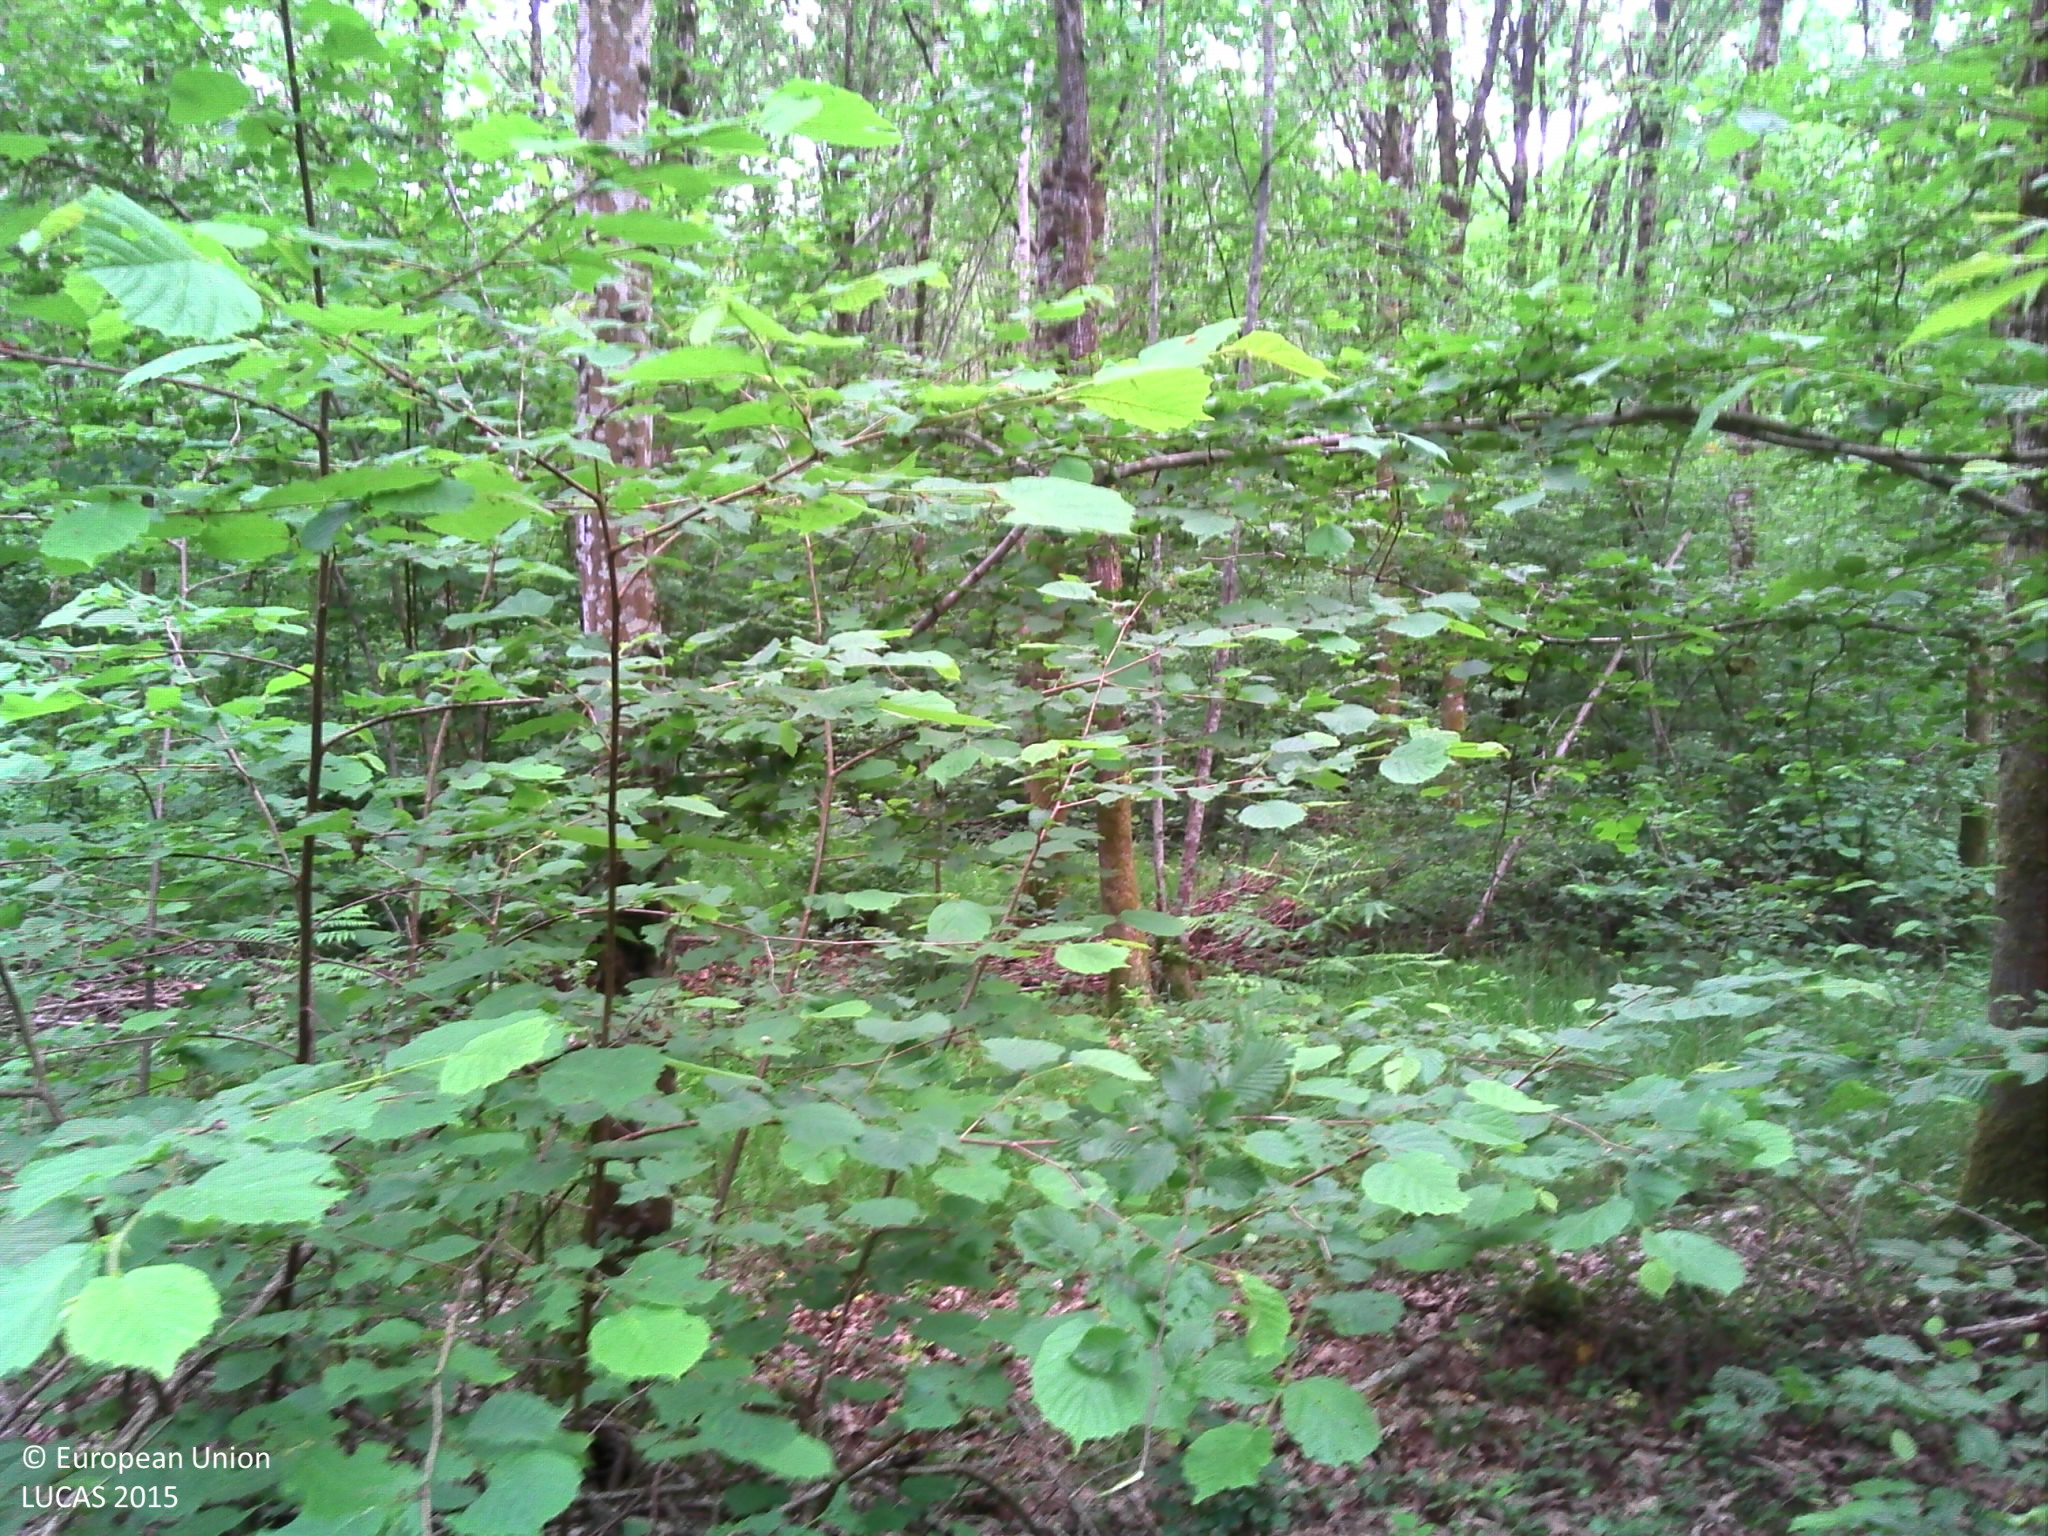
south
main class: Woodland
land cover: Broadleaved woodland
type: mesophytic deciduous forest
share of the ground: > 75 %
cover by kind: broadleaved forest trees 90 %, herbaceous plants 10 %
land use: Forestry
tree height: > 5 m
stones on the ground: < 10 %
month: June
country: FR
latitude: 47.8004
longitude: 6.2761
